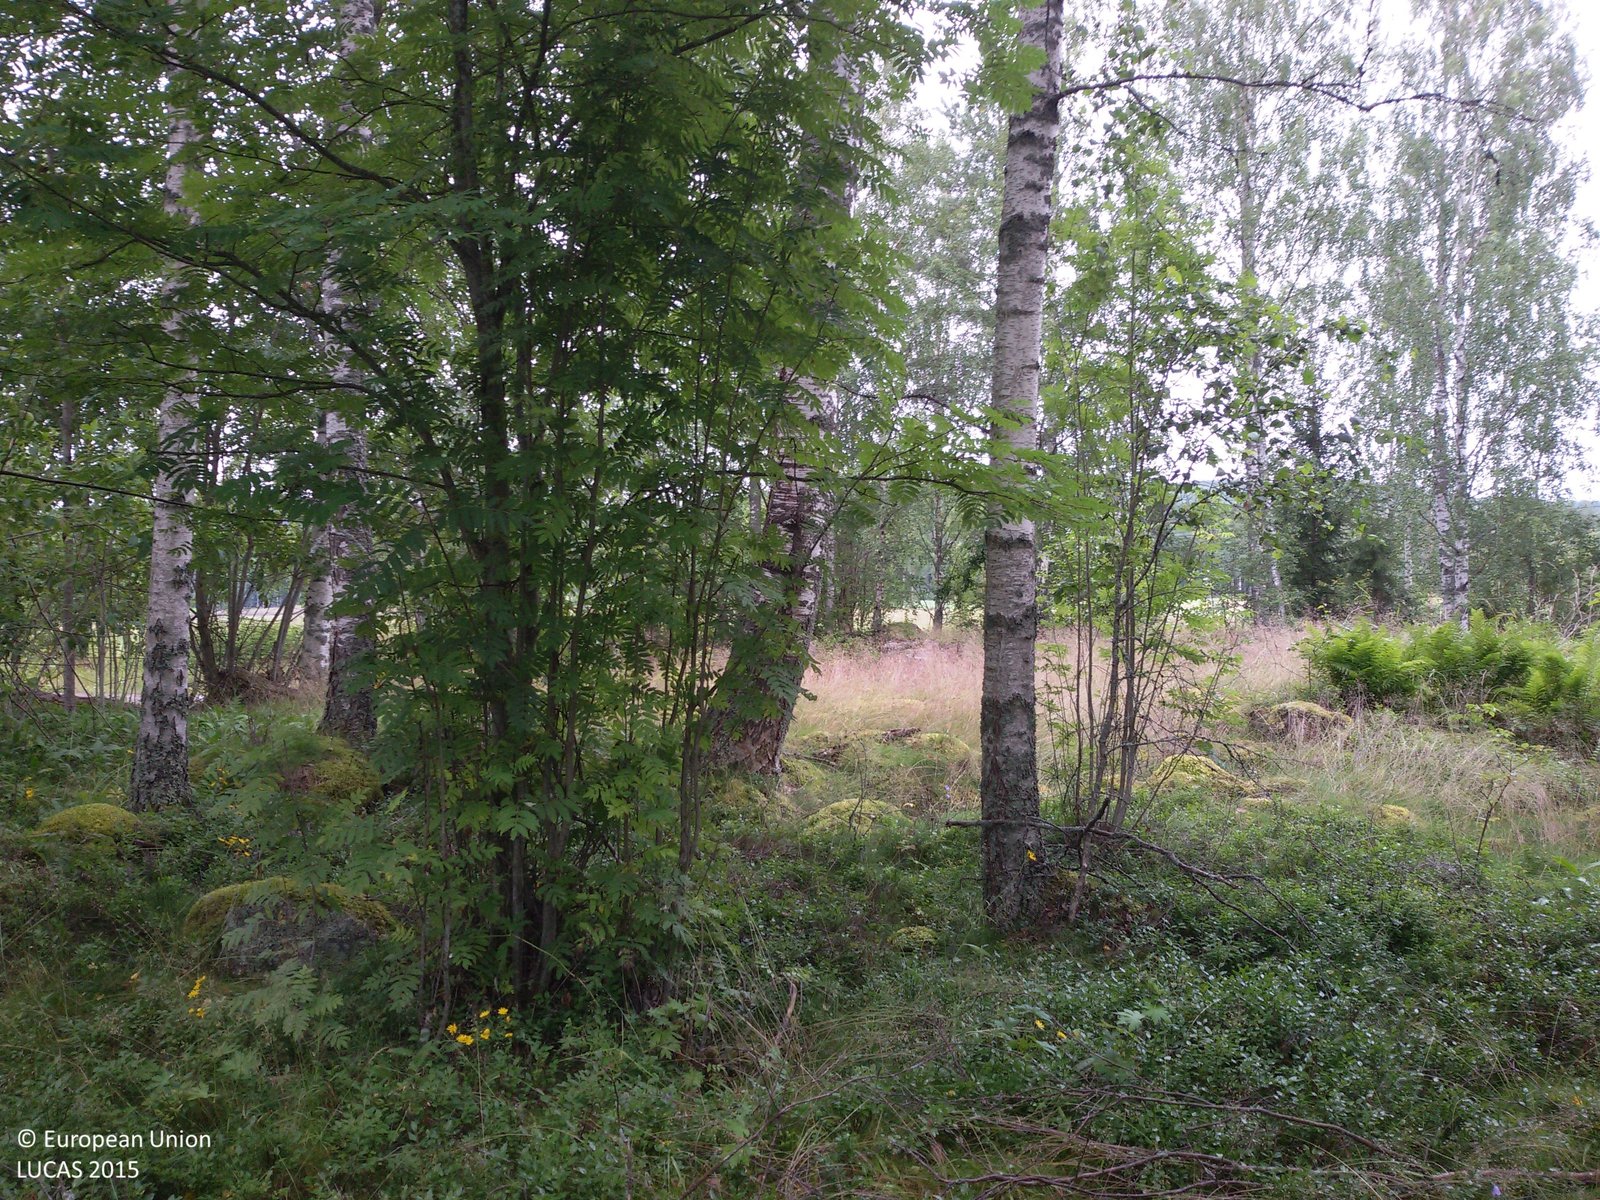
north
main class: Woodland
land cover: Pine dominated mixed woodland
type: boreal forest
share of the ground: 50 - 75 %
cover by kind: coniferous forest trees 35 %, broadleaved forest trees 35 %, shrubs 25 %, herbaceous plants 5 %
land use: Forestry
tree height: > 5 m
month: July
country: SE
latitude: 60.4353
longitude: 15.9295
